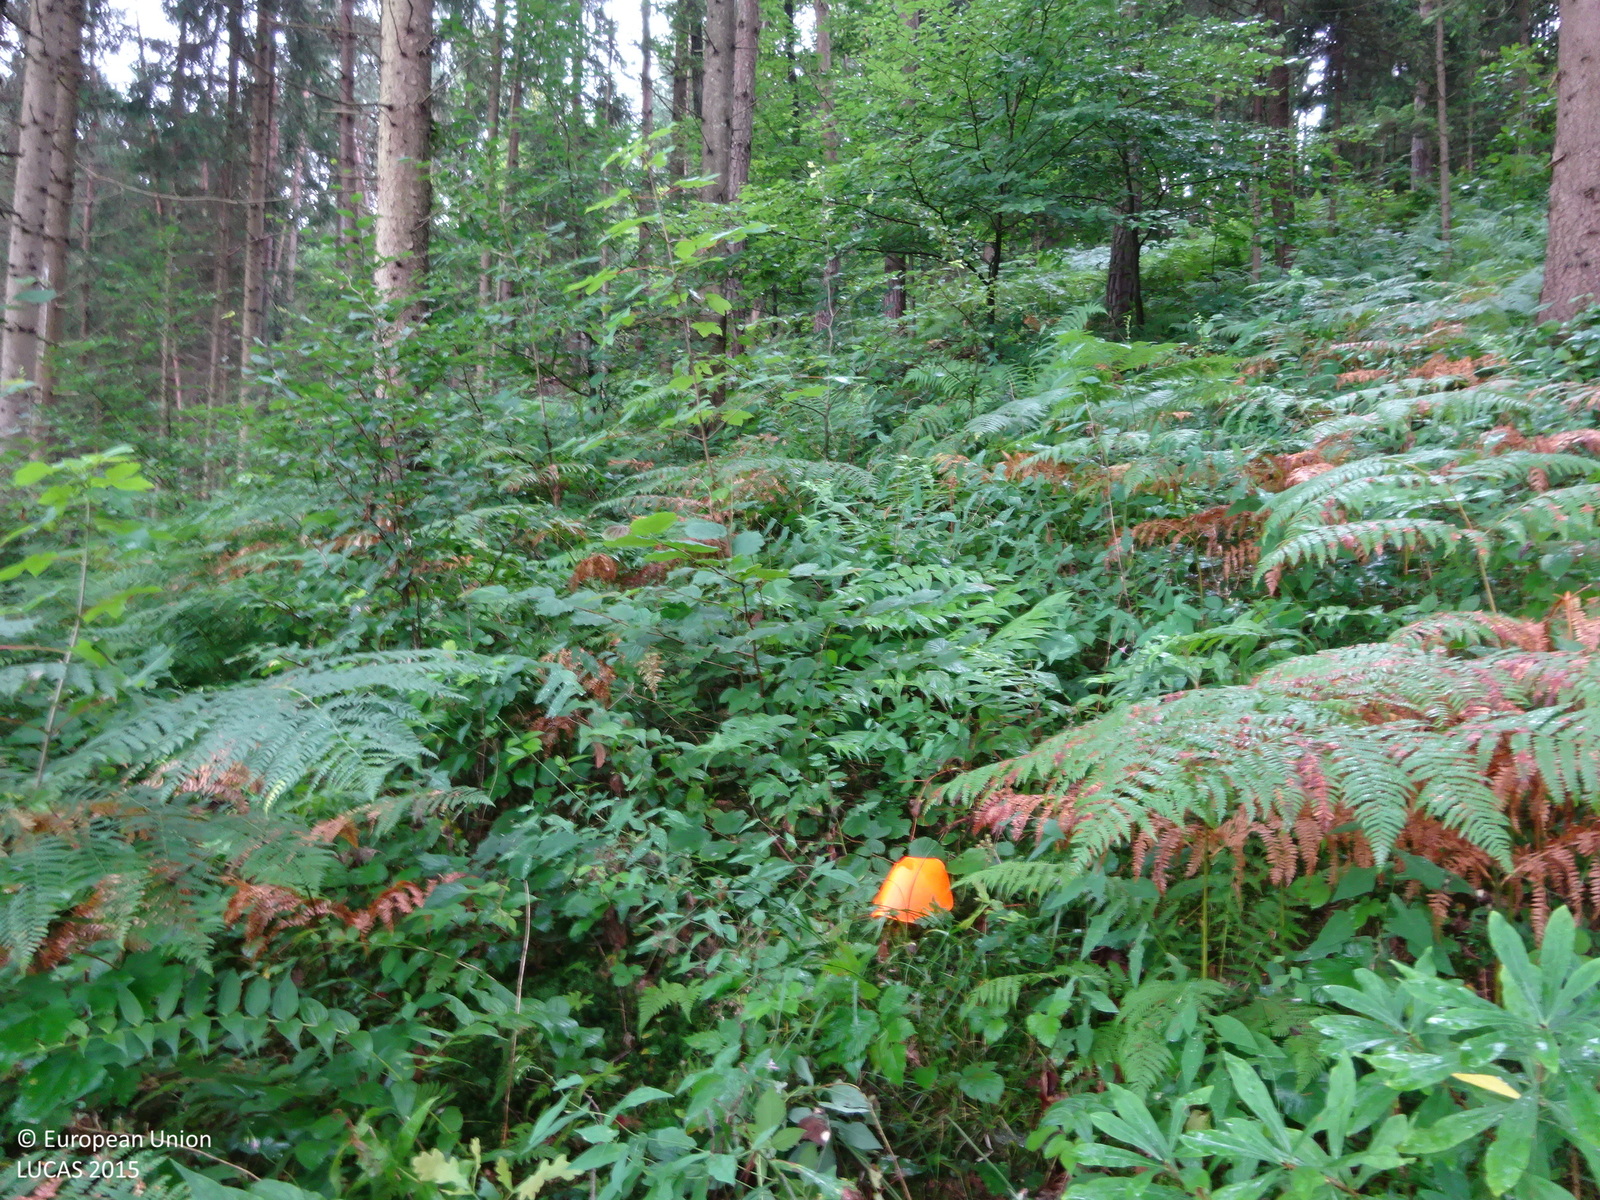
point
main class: Woodland
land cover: Spruce dominated coniferous woodland
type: alpine coniferous forest
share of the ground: > 75 %
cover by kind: coniferous forest trees 90 %, shrubs 5 %, herbaceous plants 5 %
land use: Forestry
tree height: > 5 m
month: July
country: AT
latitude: 46.7932
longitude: 15.3835
